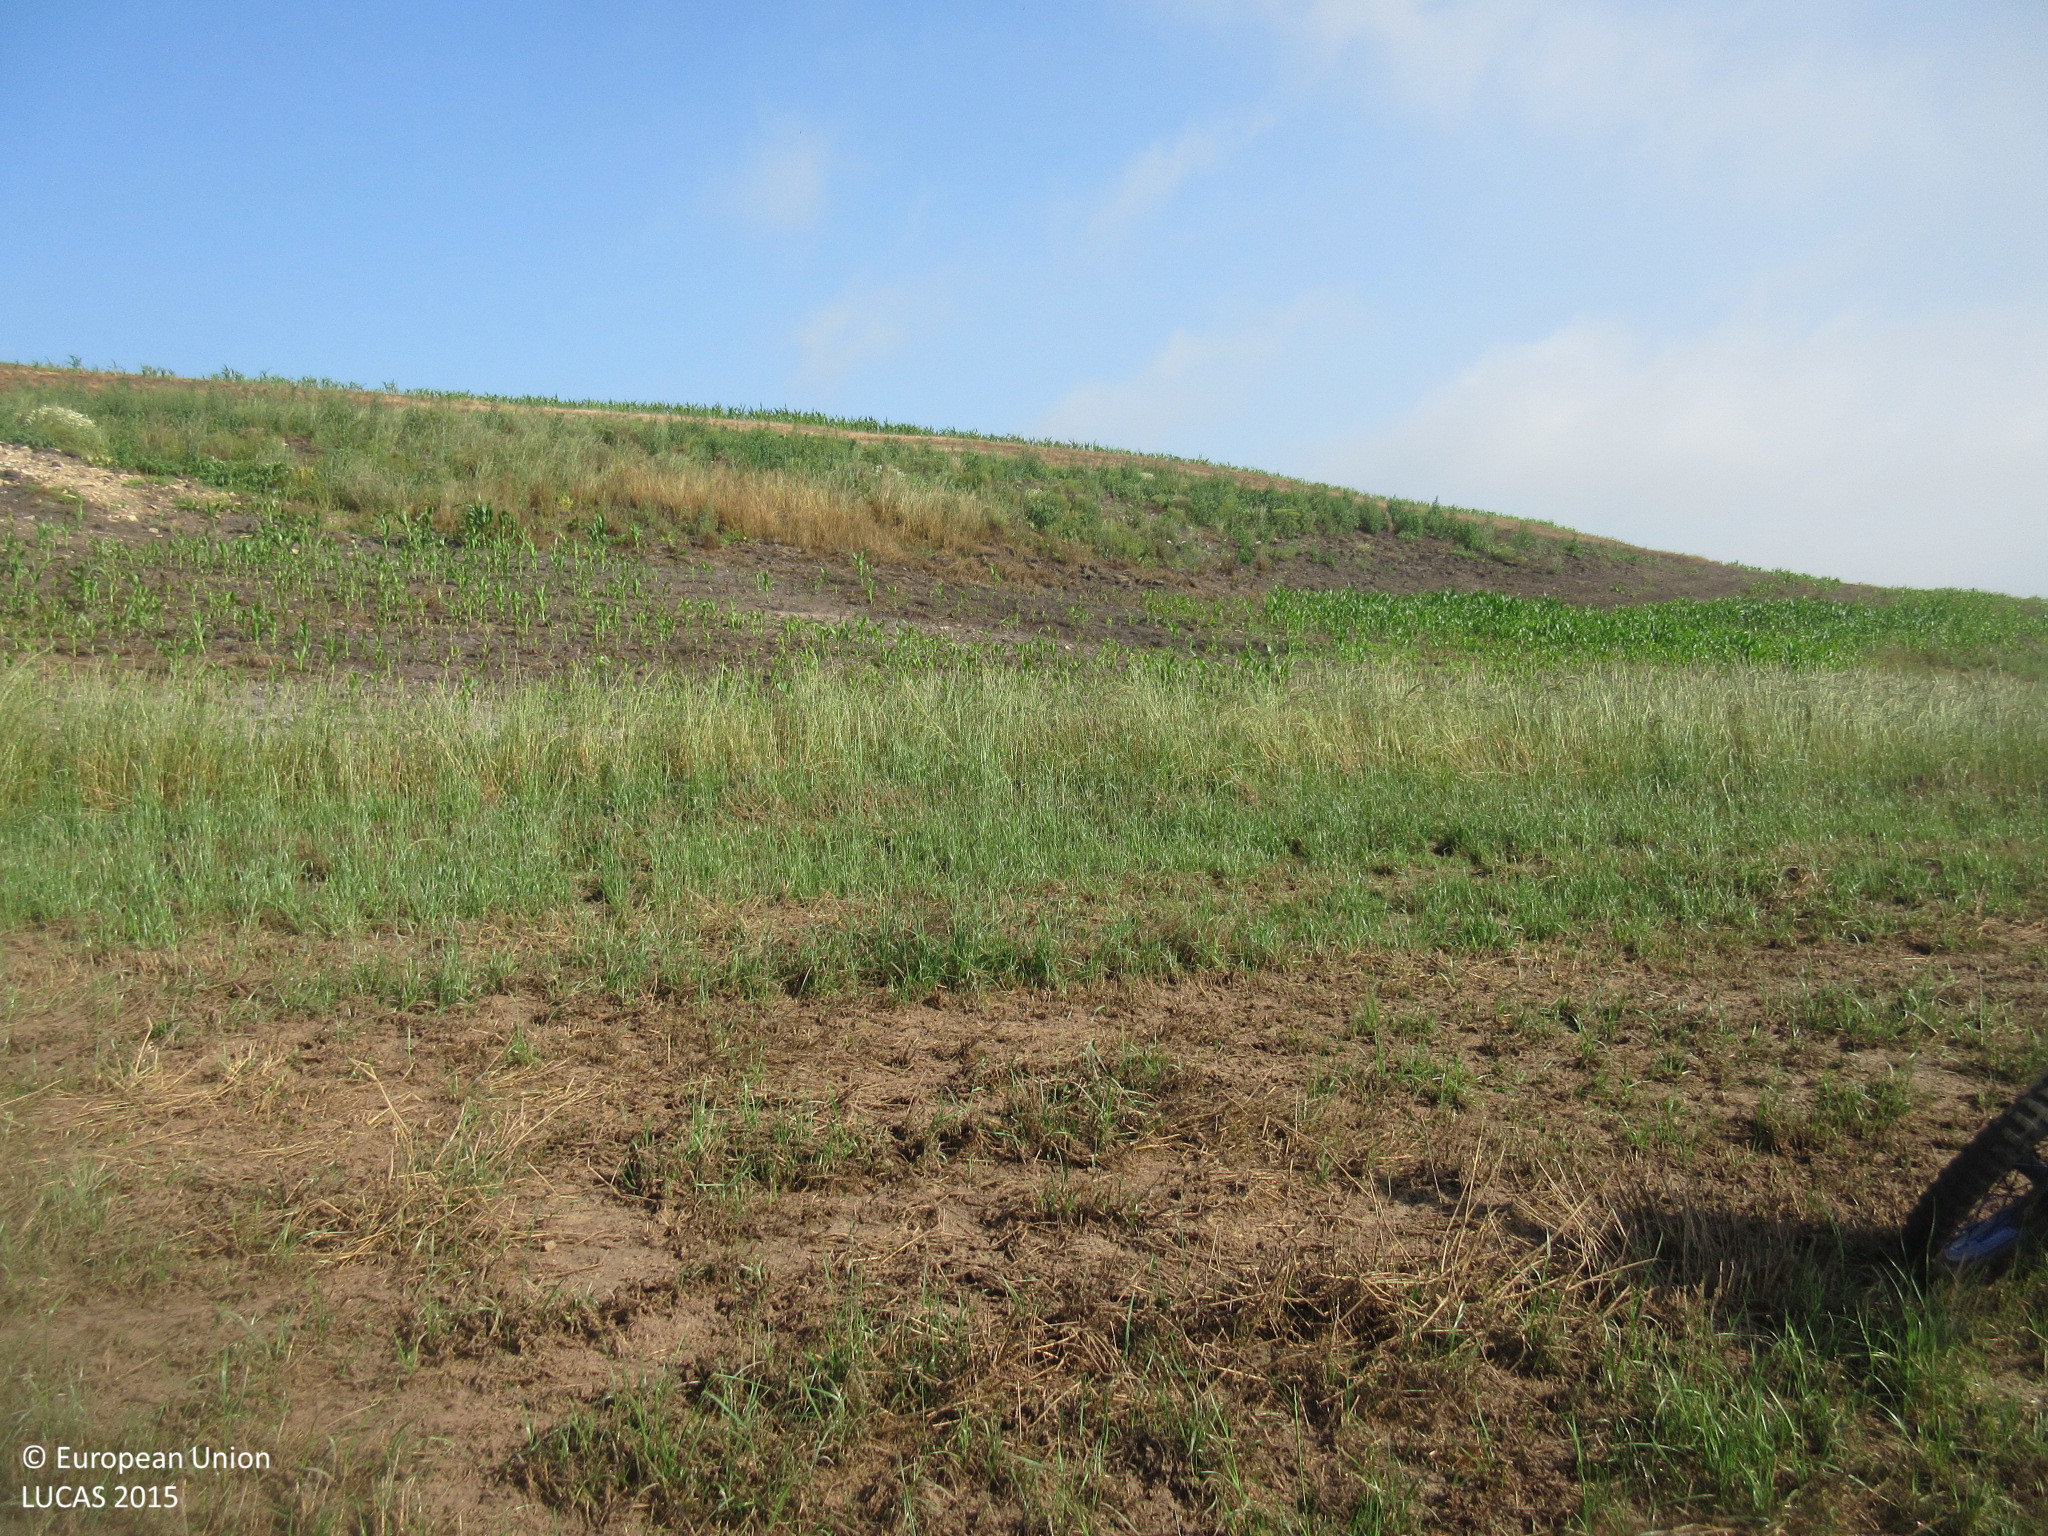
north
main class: Grassland
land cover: Grassland without tree/shrub cover
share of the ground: > 75 %
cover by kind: herbaceous plants 100 %
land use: Agriculture (excluding fallow land and kitchen gardens)
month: July
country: ES
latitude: 43.3557
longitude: -6.3486
